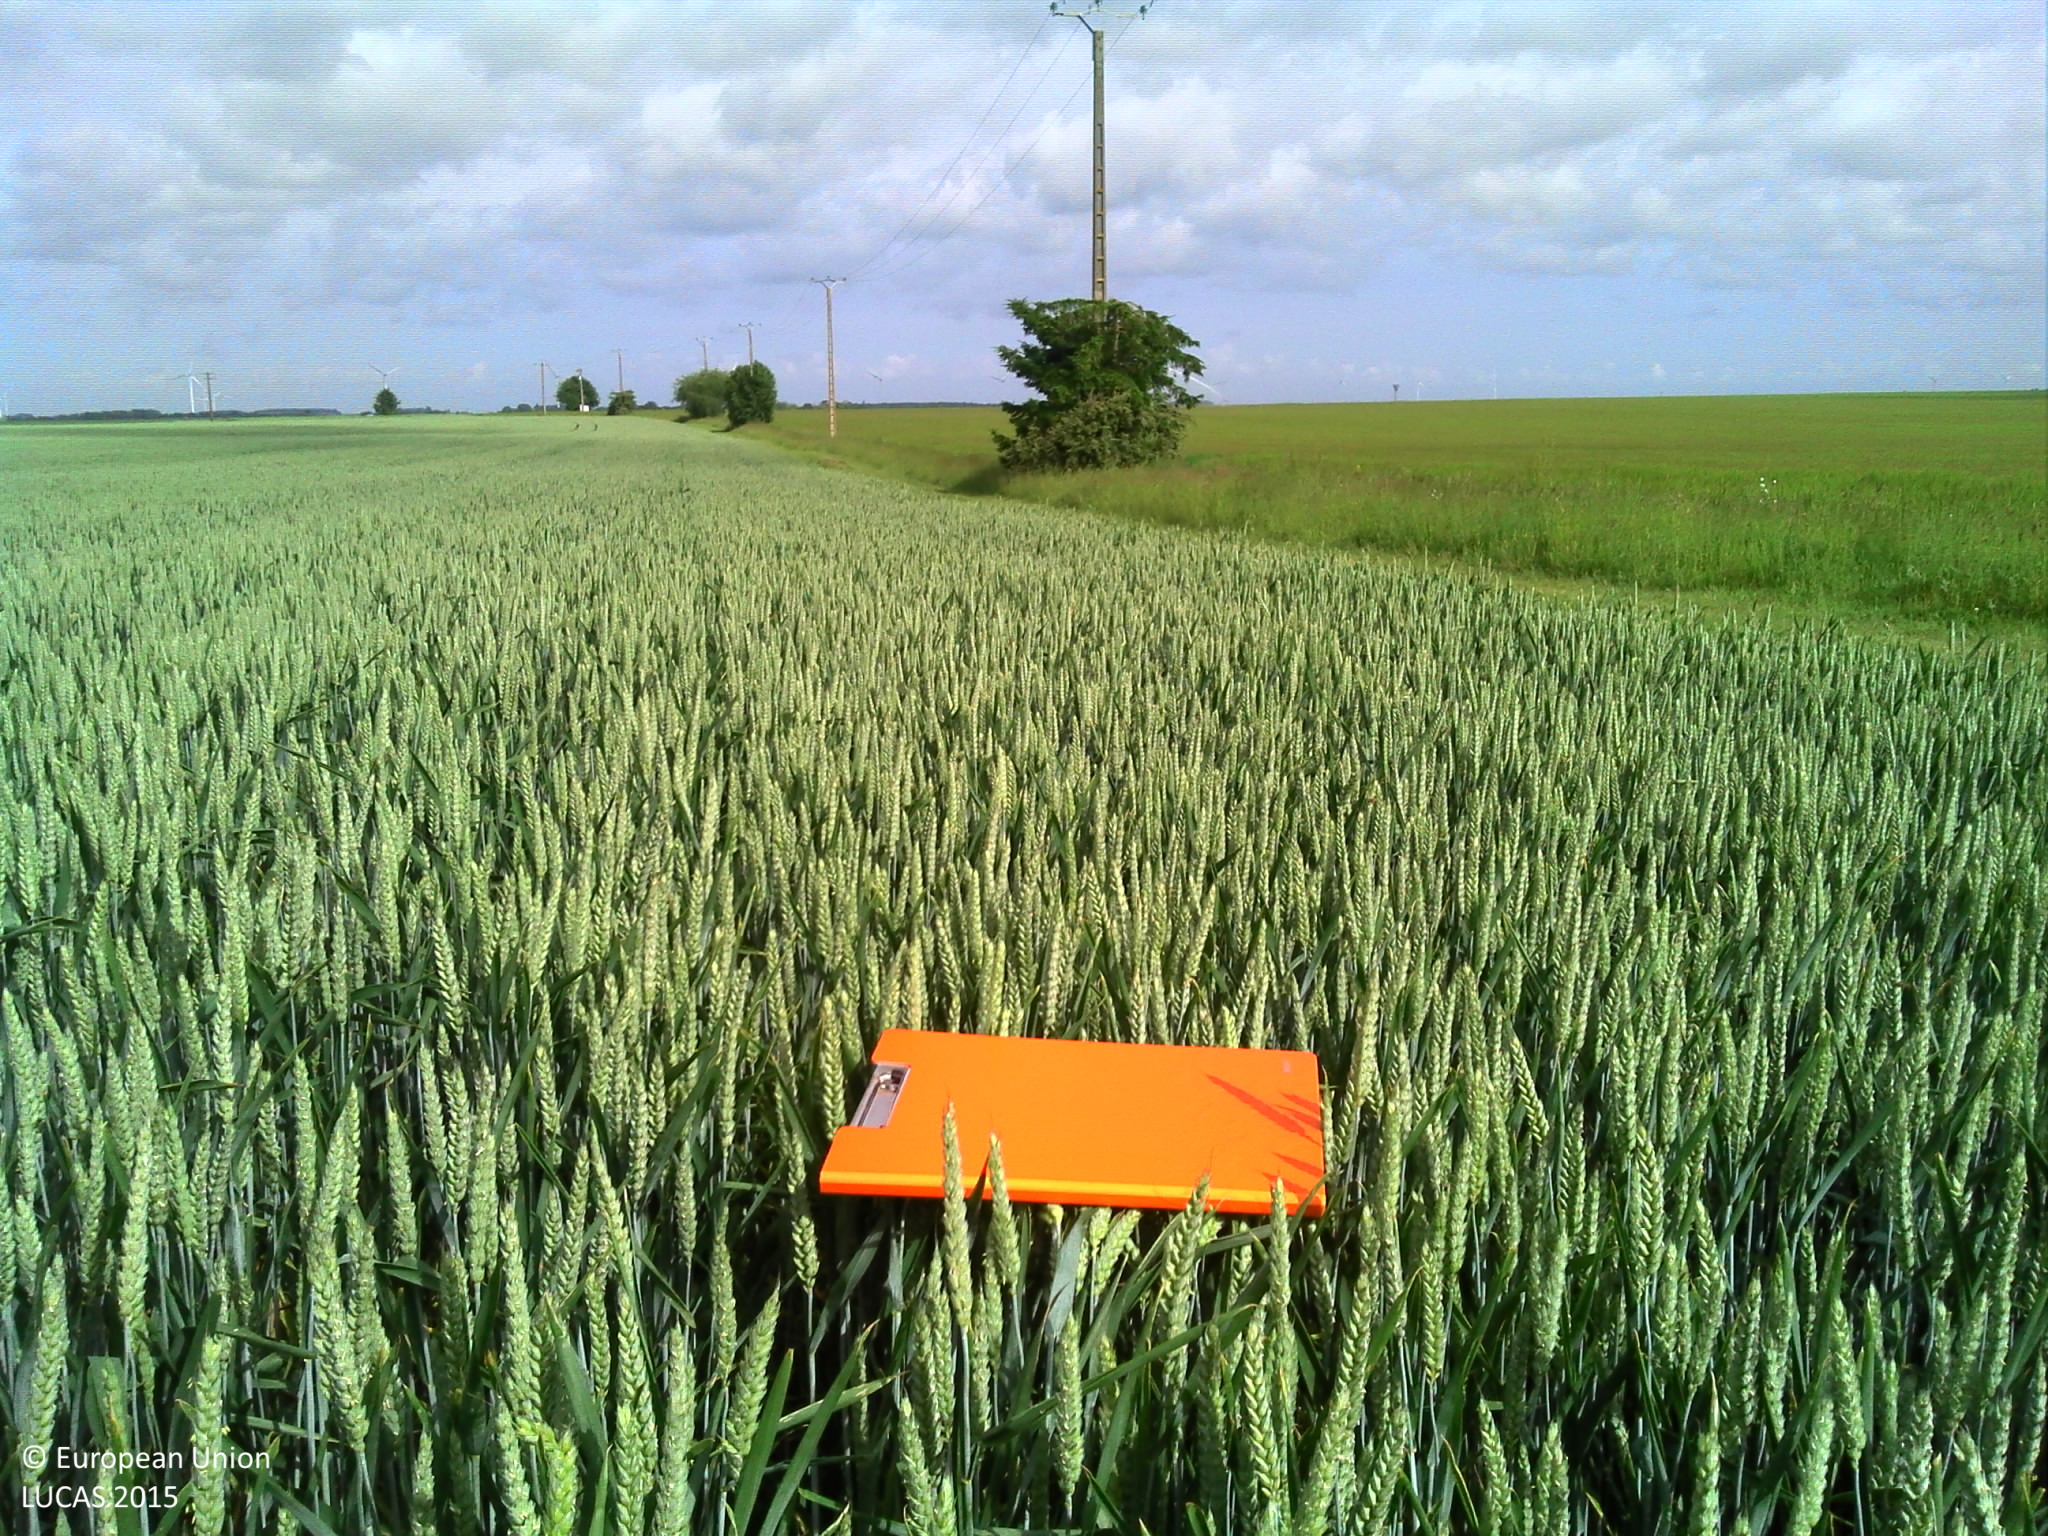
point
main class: Cropland
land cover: Common wheat
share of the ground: > 75 %
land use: Agriculture (excluding fallow land and kitchen gardens)
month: June
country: FR
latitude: 48.3057
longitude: 1.9105
